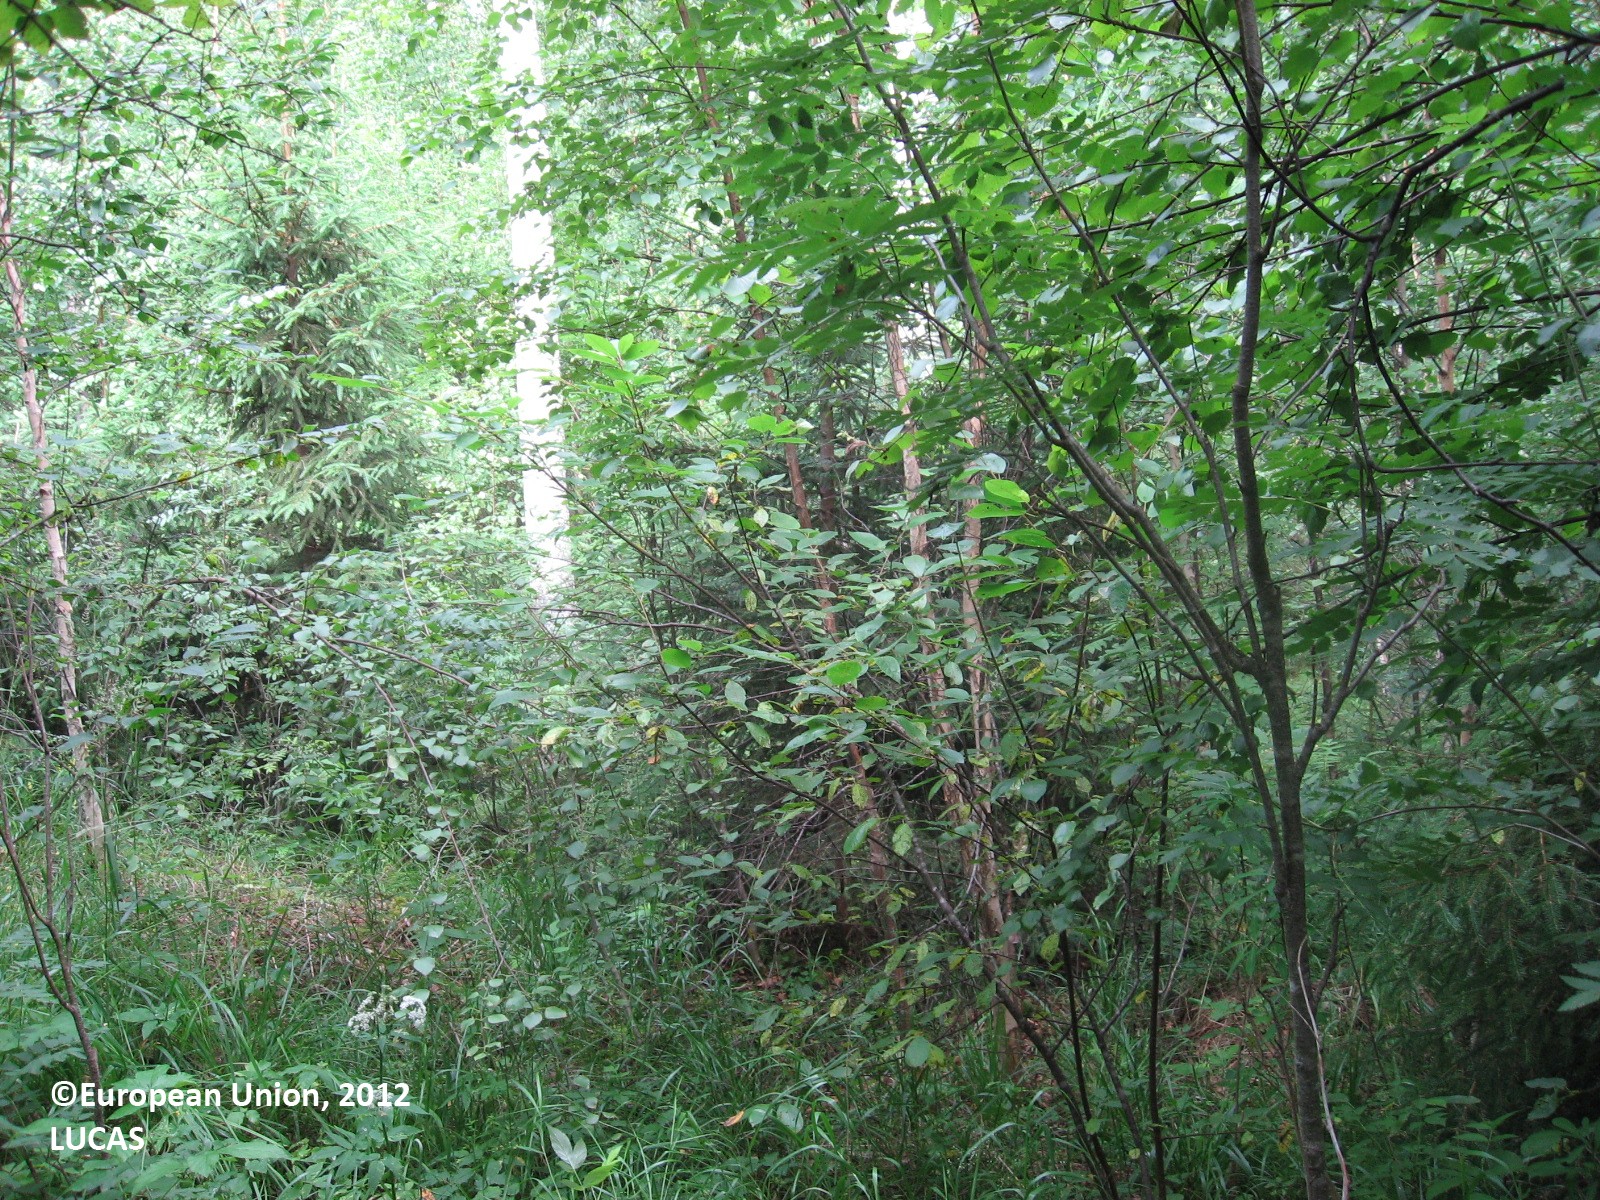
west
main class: Woodland
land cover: Broadleaved woodland
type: boreal forest
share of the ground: > 75 %
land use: Forestry
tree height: > 5 m
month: July
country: FI
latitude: 61.2256
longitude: 25.7164
